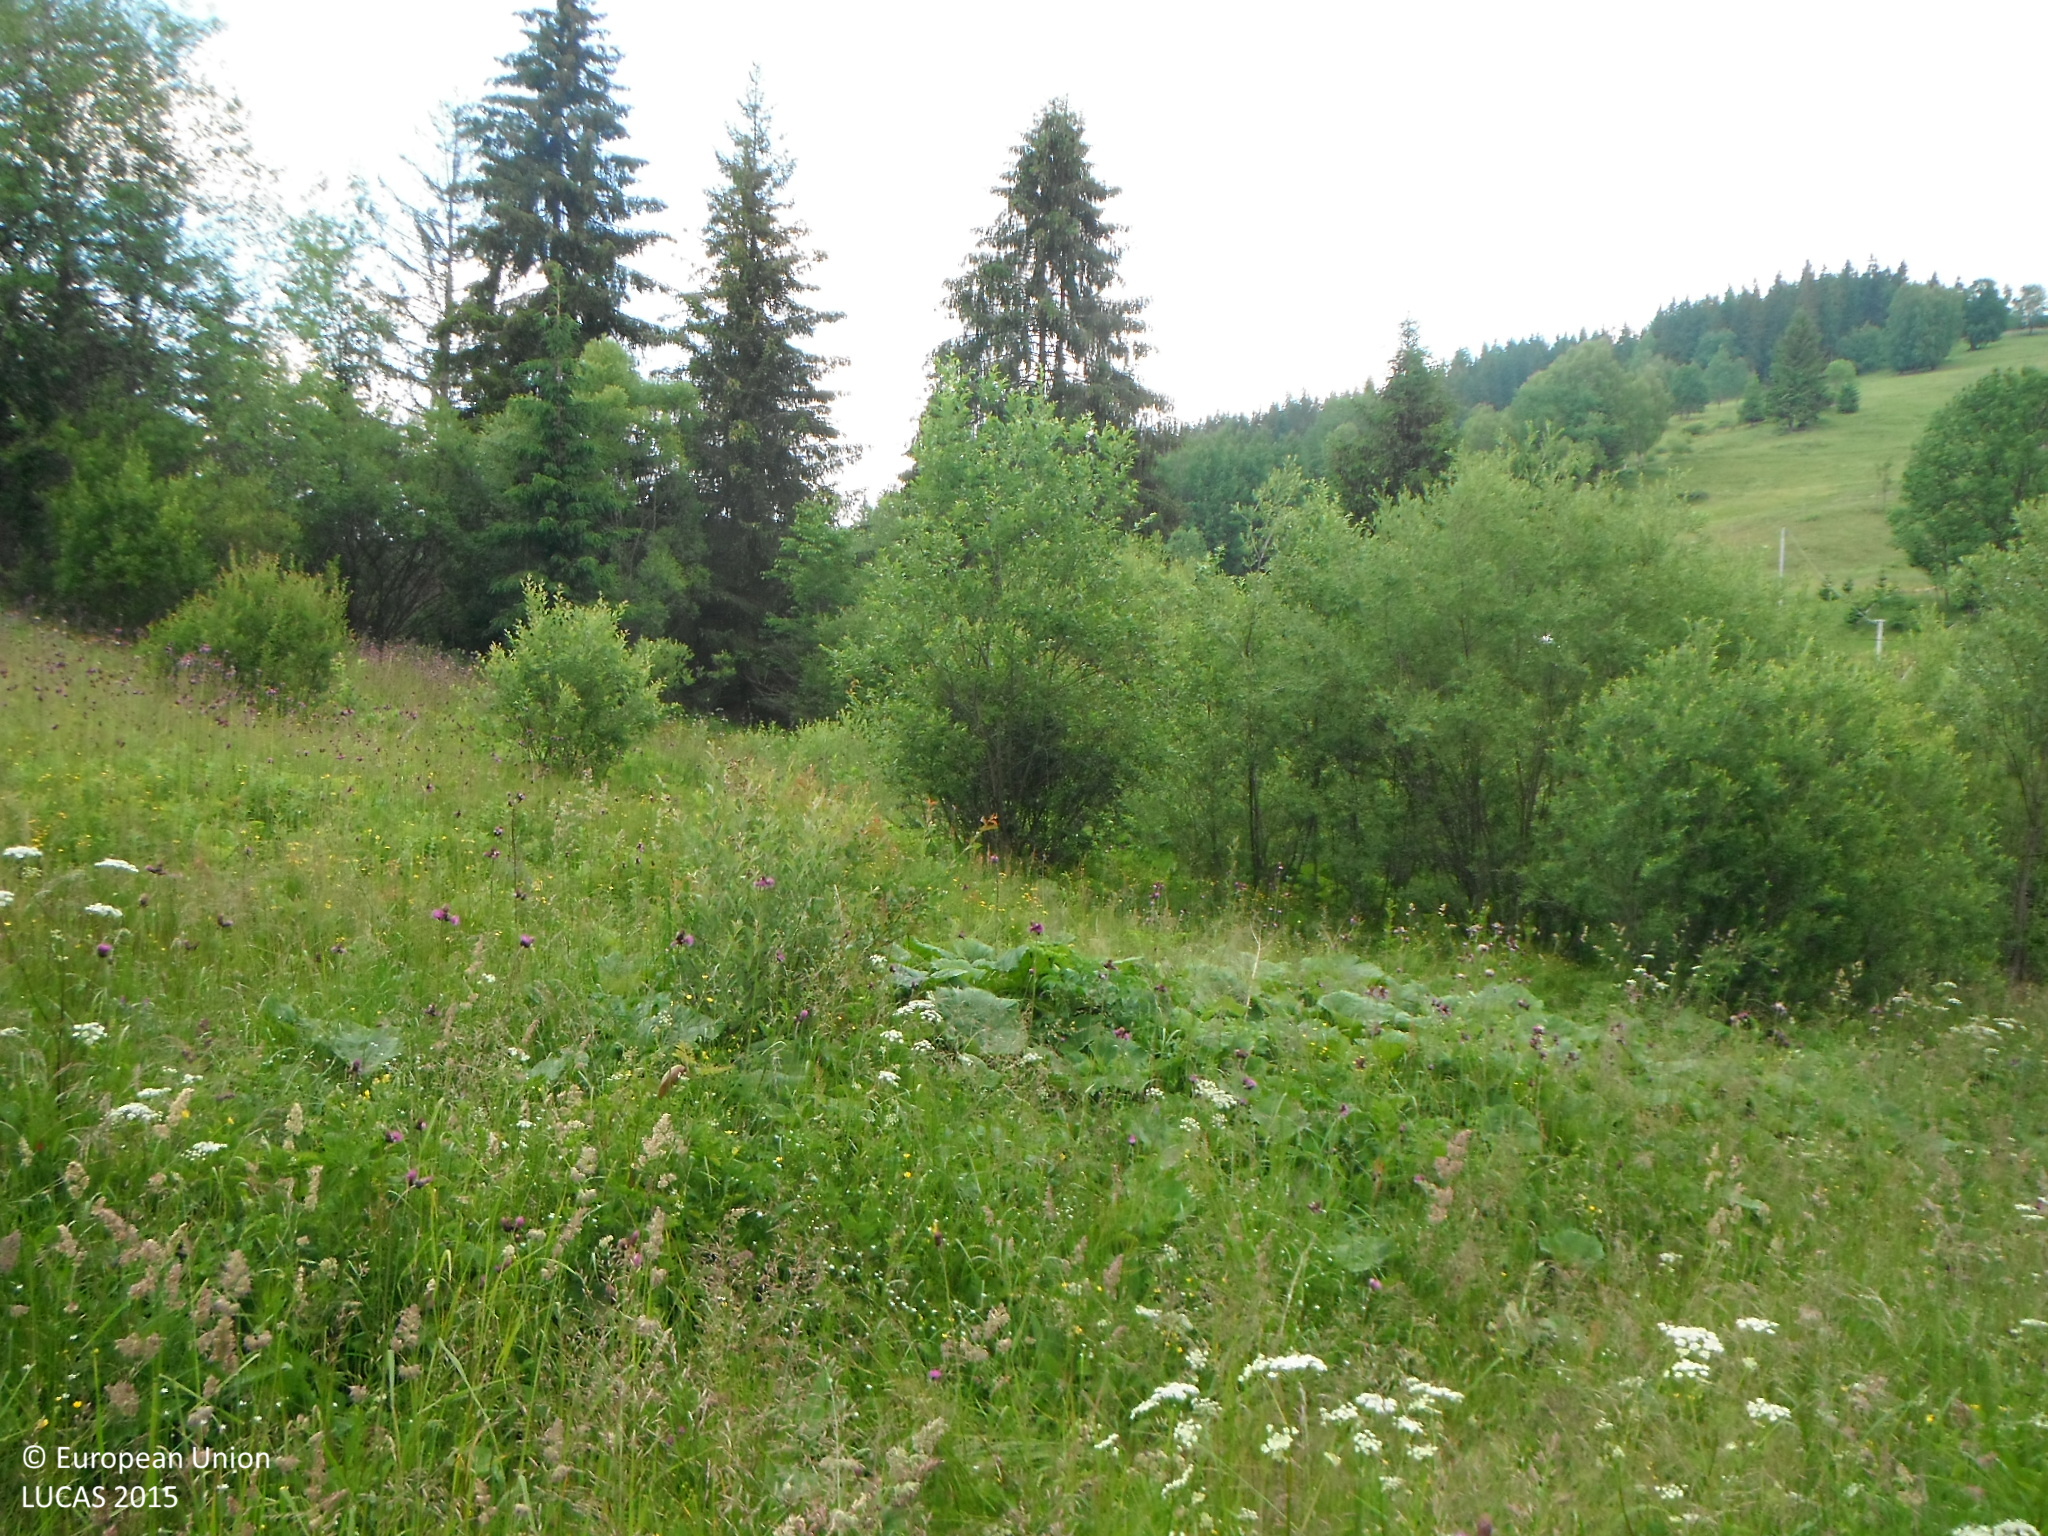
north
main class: Grassland
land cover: Spontaneously vegetated surfaces
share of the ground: > 75 %
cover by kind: herbaceous plants 100 %
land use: Semi-natural and natural areas not in use
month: July
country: SK
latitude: 49.4431
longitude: 19.2790
